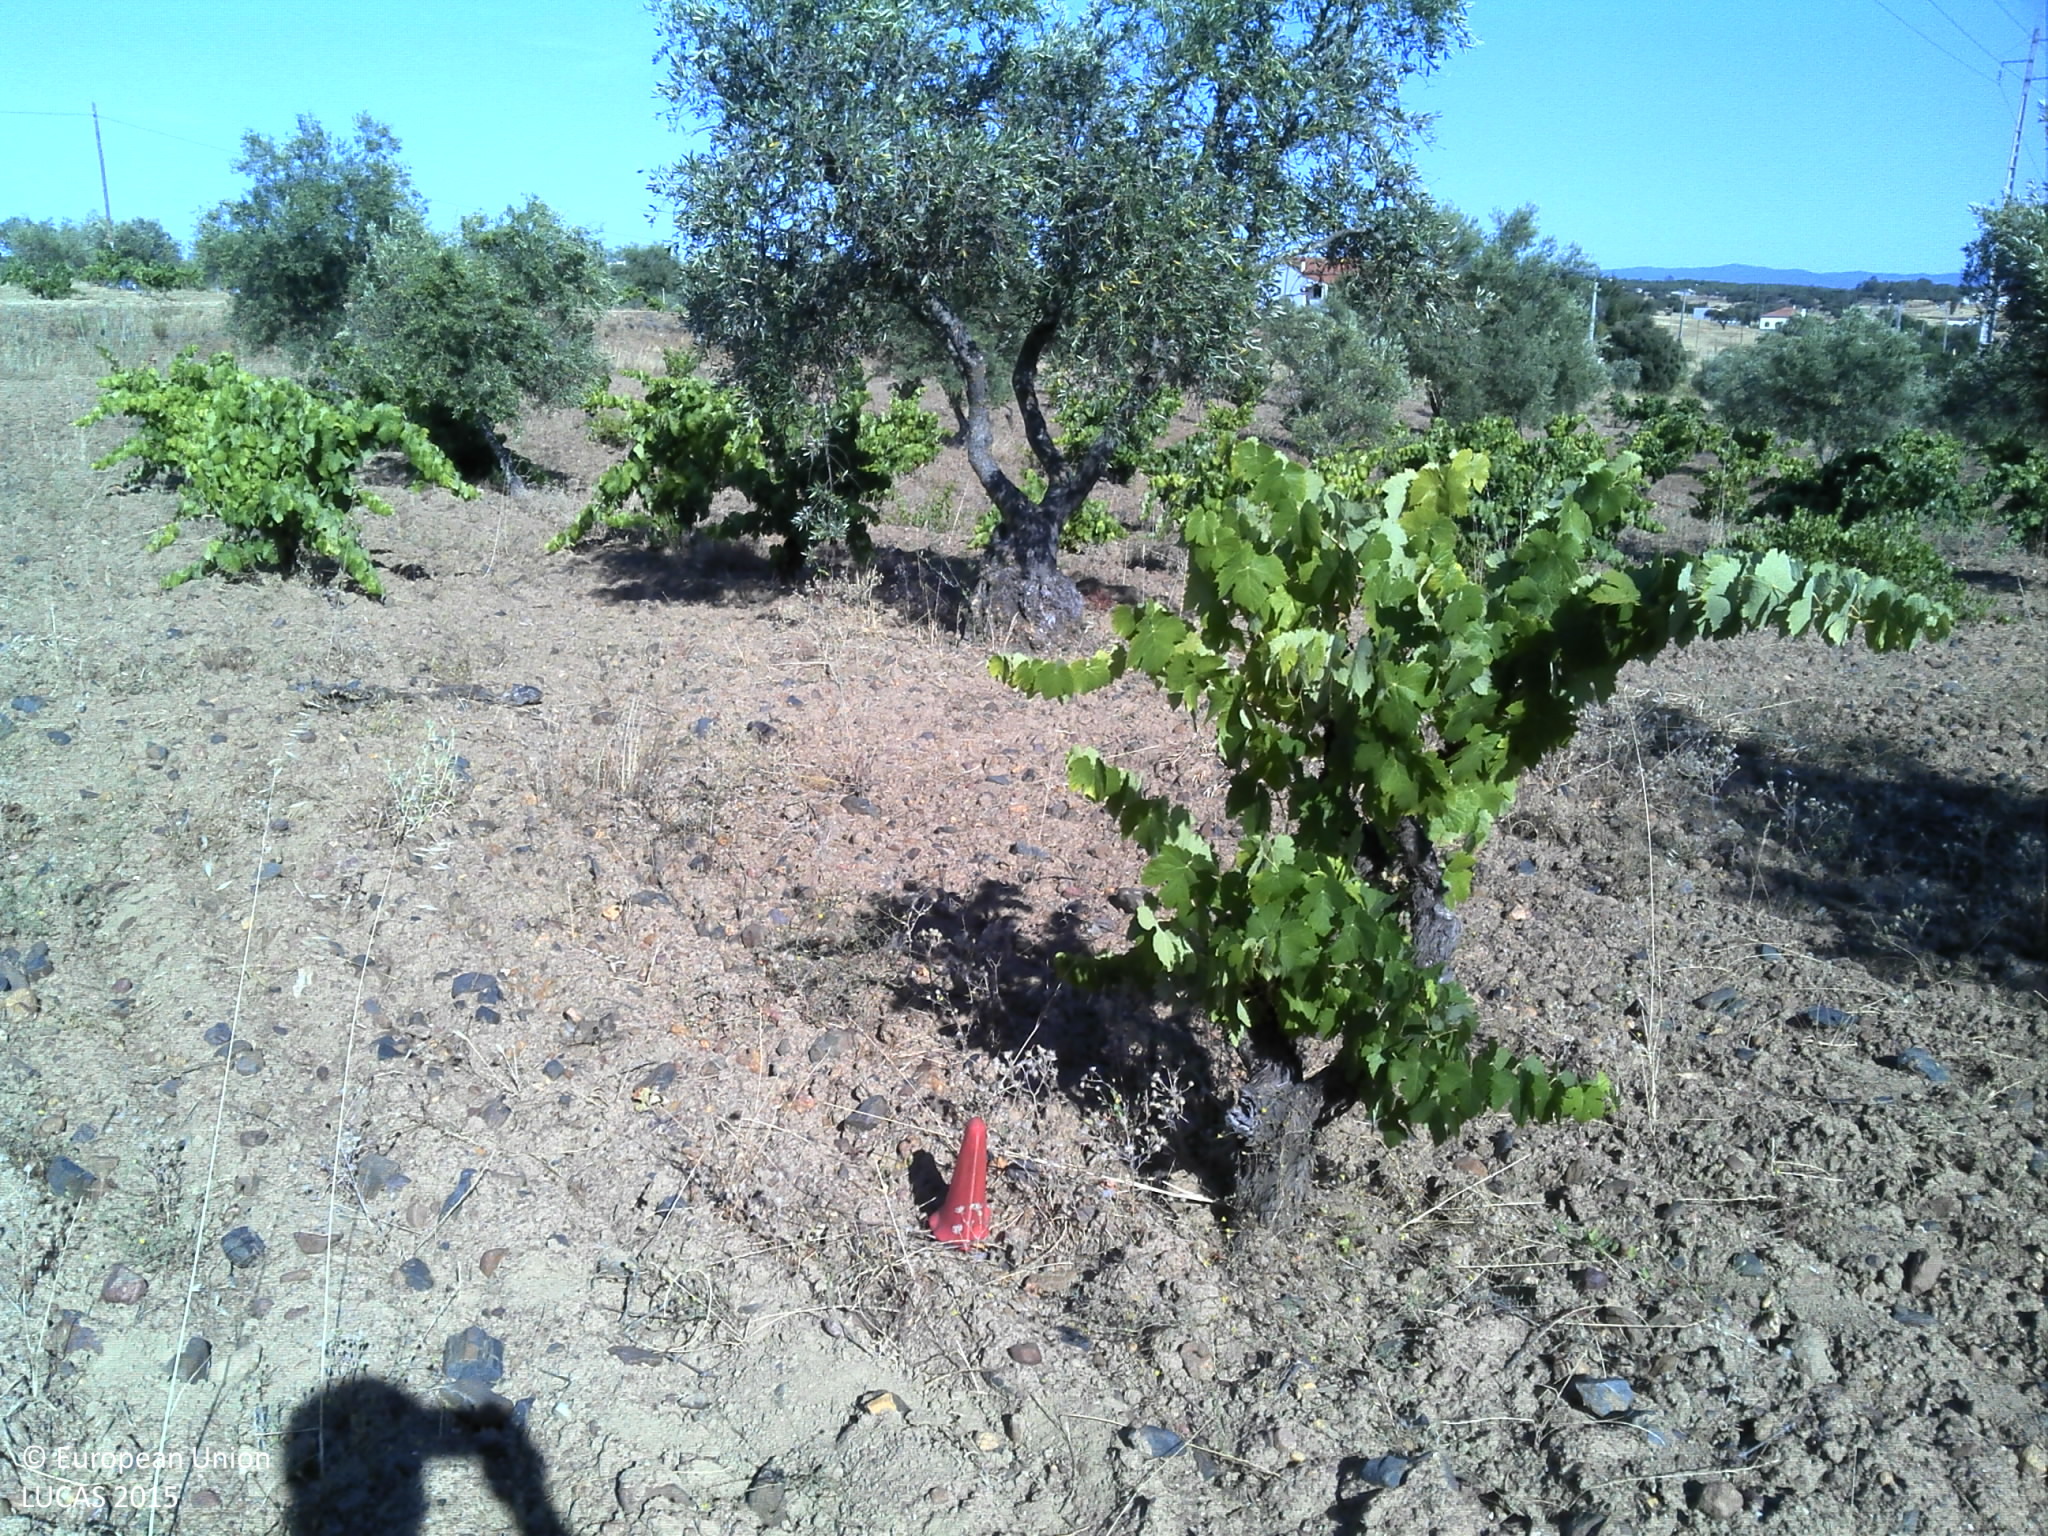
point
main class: Cropland
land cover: Olive groves
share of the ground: 25 - 50 %
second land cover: Vineyards
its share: 25 - 50 %
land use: Agriculture (excluding fallow land and kitchen gardens)
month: July
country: PT
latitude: 38.2309
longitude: -7.2335
